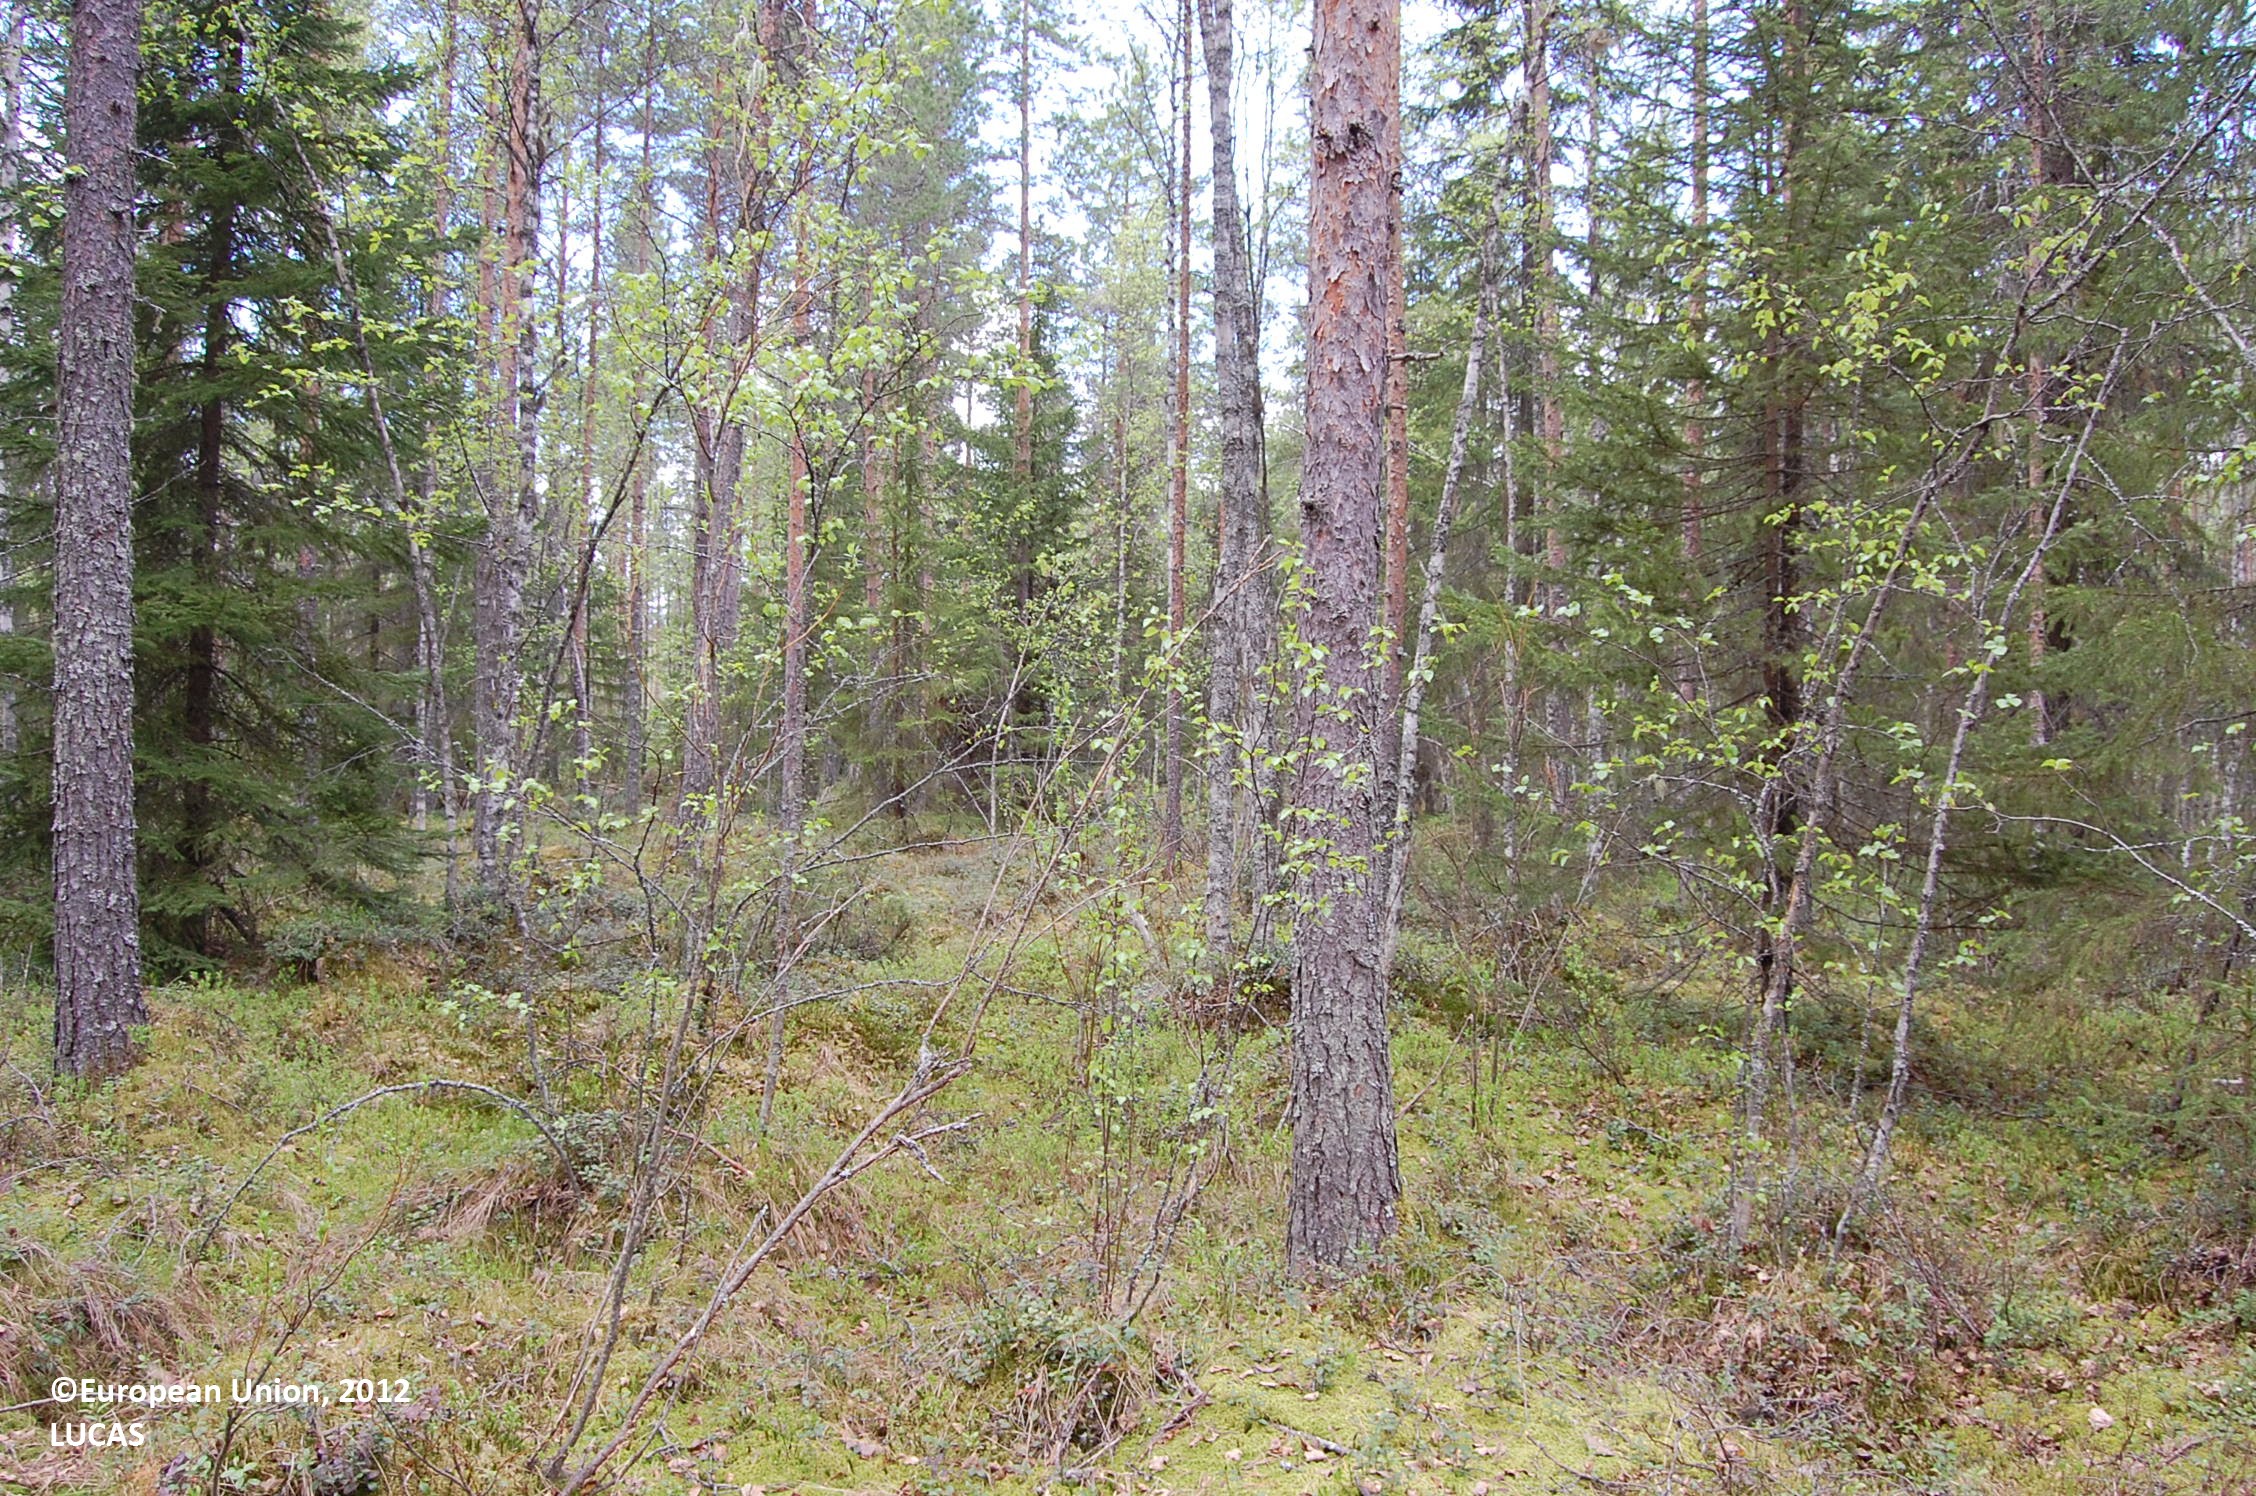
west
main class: Woodland
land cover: Other mixed woodland
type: boreal forest
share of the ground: > 75 %
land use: Forestry
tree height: > 5 m
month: May
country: FI
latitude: 64.3632
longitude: 26.2892
